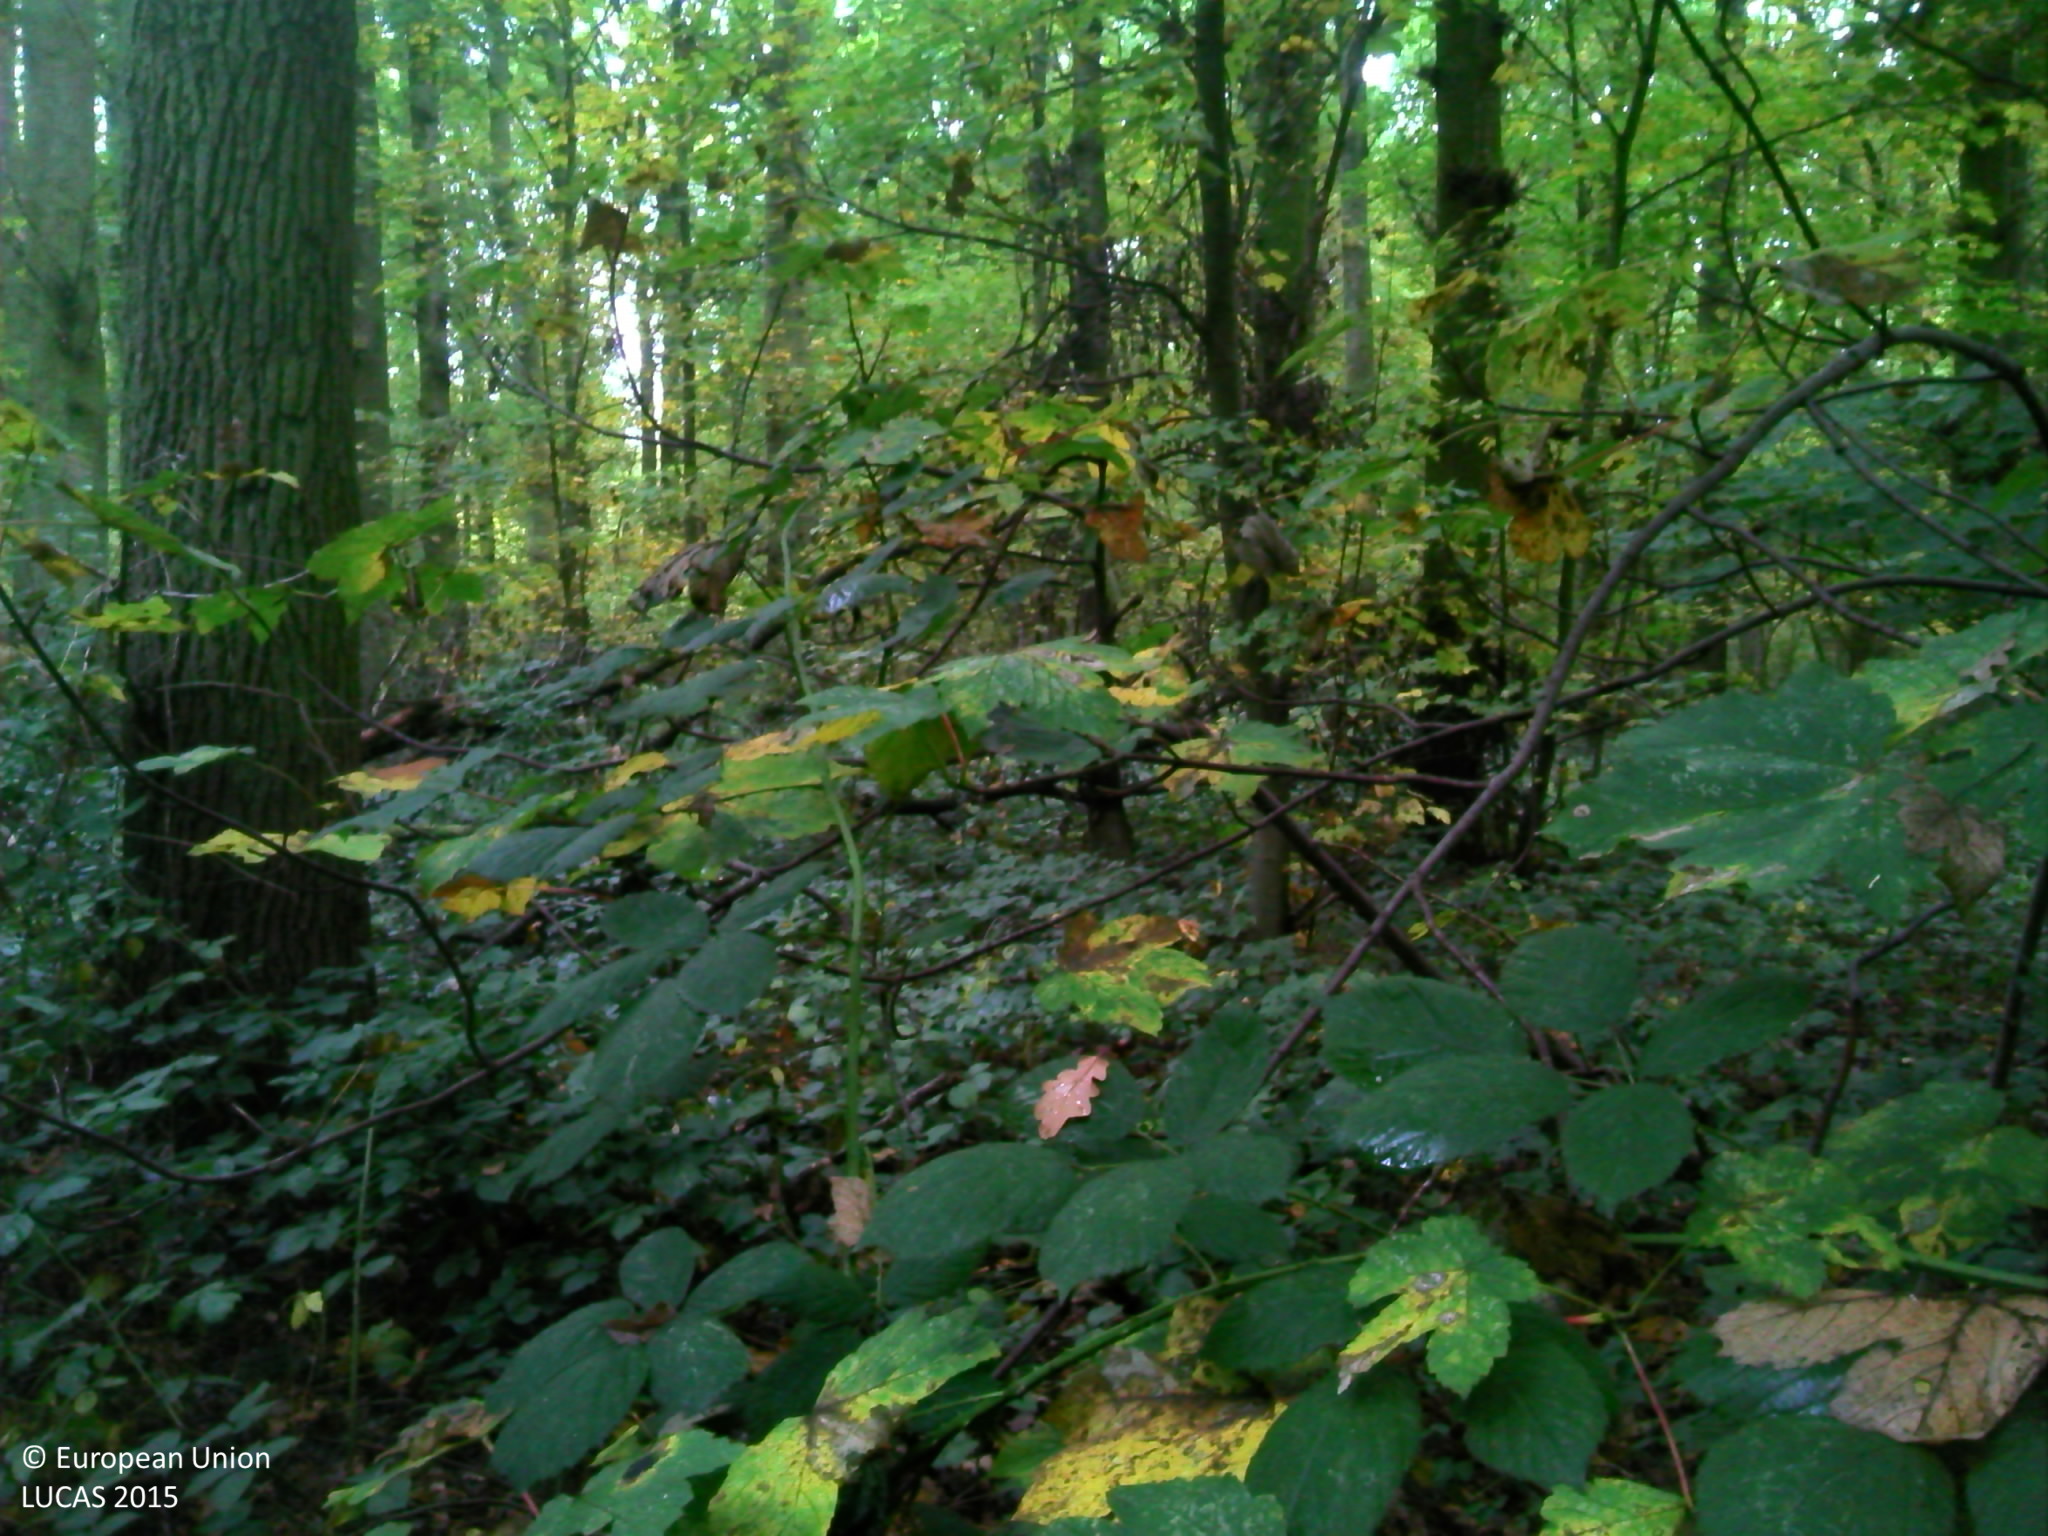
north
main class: Woodland
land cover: Broadleaved woodland
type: mesophytic deciduous forest
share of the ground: > 75 %
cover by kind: broadleaved forest trees 95 %, herbaceous plants 5 %
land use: Forestry
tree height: > 5 m
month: October
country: BE
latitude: 50.9355
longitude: 4.5173
